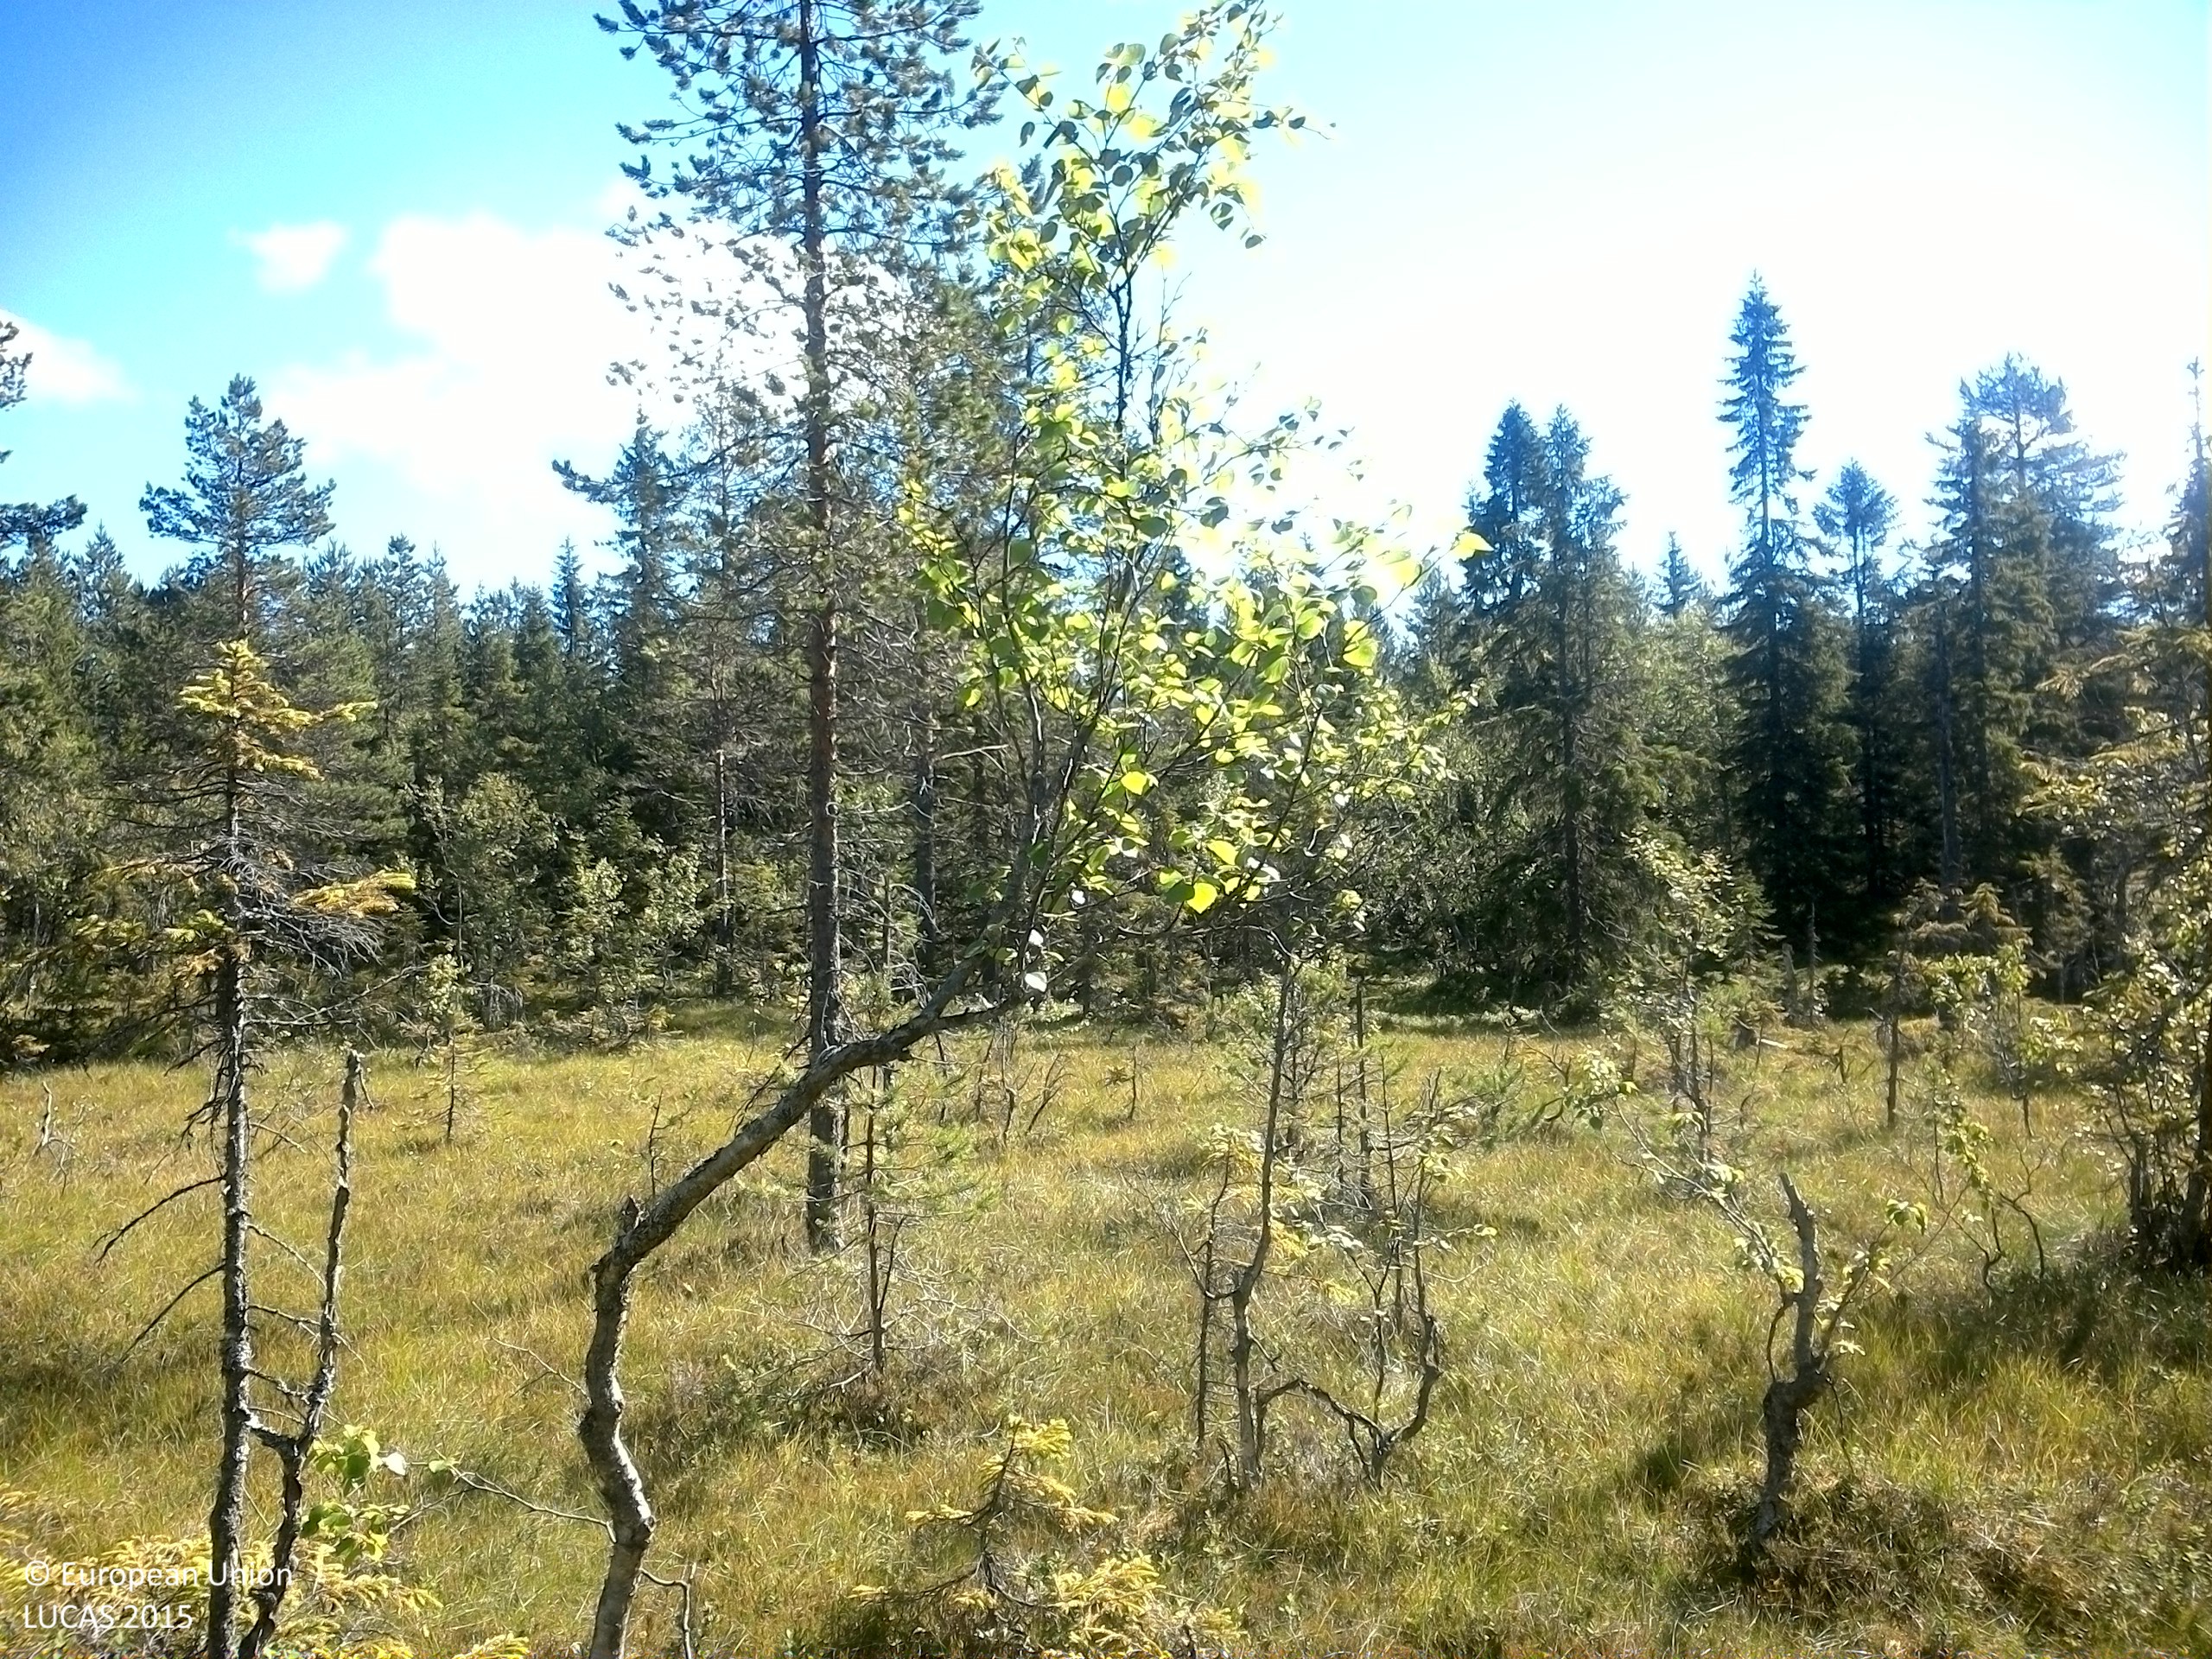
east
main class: Woodland
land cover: Spruce dominated mixed woodland
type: boreal forest
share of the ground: 25 - 50 %
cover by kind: shrubs 40 %, coniferous forest trees 20 %, lichens and mosses 20 %, broadleaved forest trees 10 %, herbaceous plants 10 %
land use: Semi-natural and natural areas not in use
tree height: > 5 m
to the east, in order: Spruce dominated mixed woodland; Peatbogs; Pine dominated mixed woodland; Spruce dominated mixed woodland; Pine dominated coniferous woodland; Spruce dominated mixed woodland
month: August
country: SE
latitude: 62.8178
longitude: 17.2575
